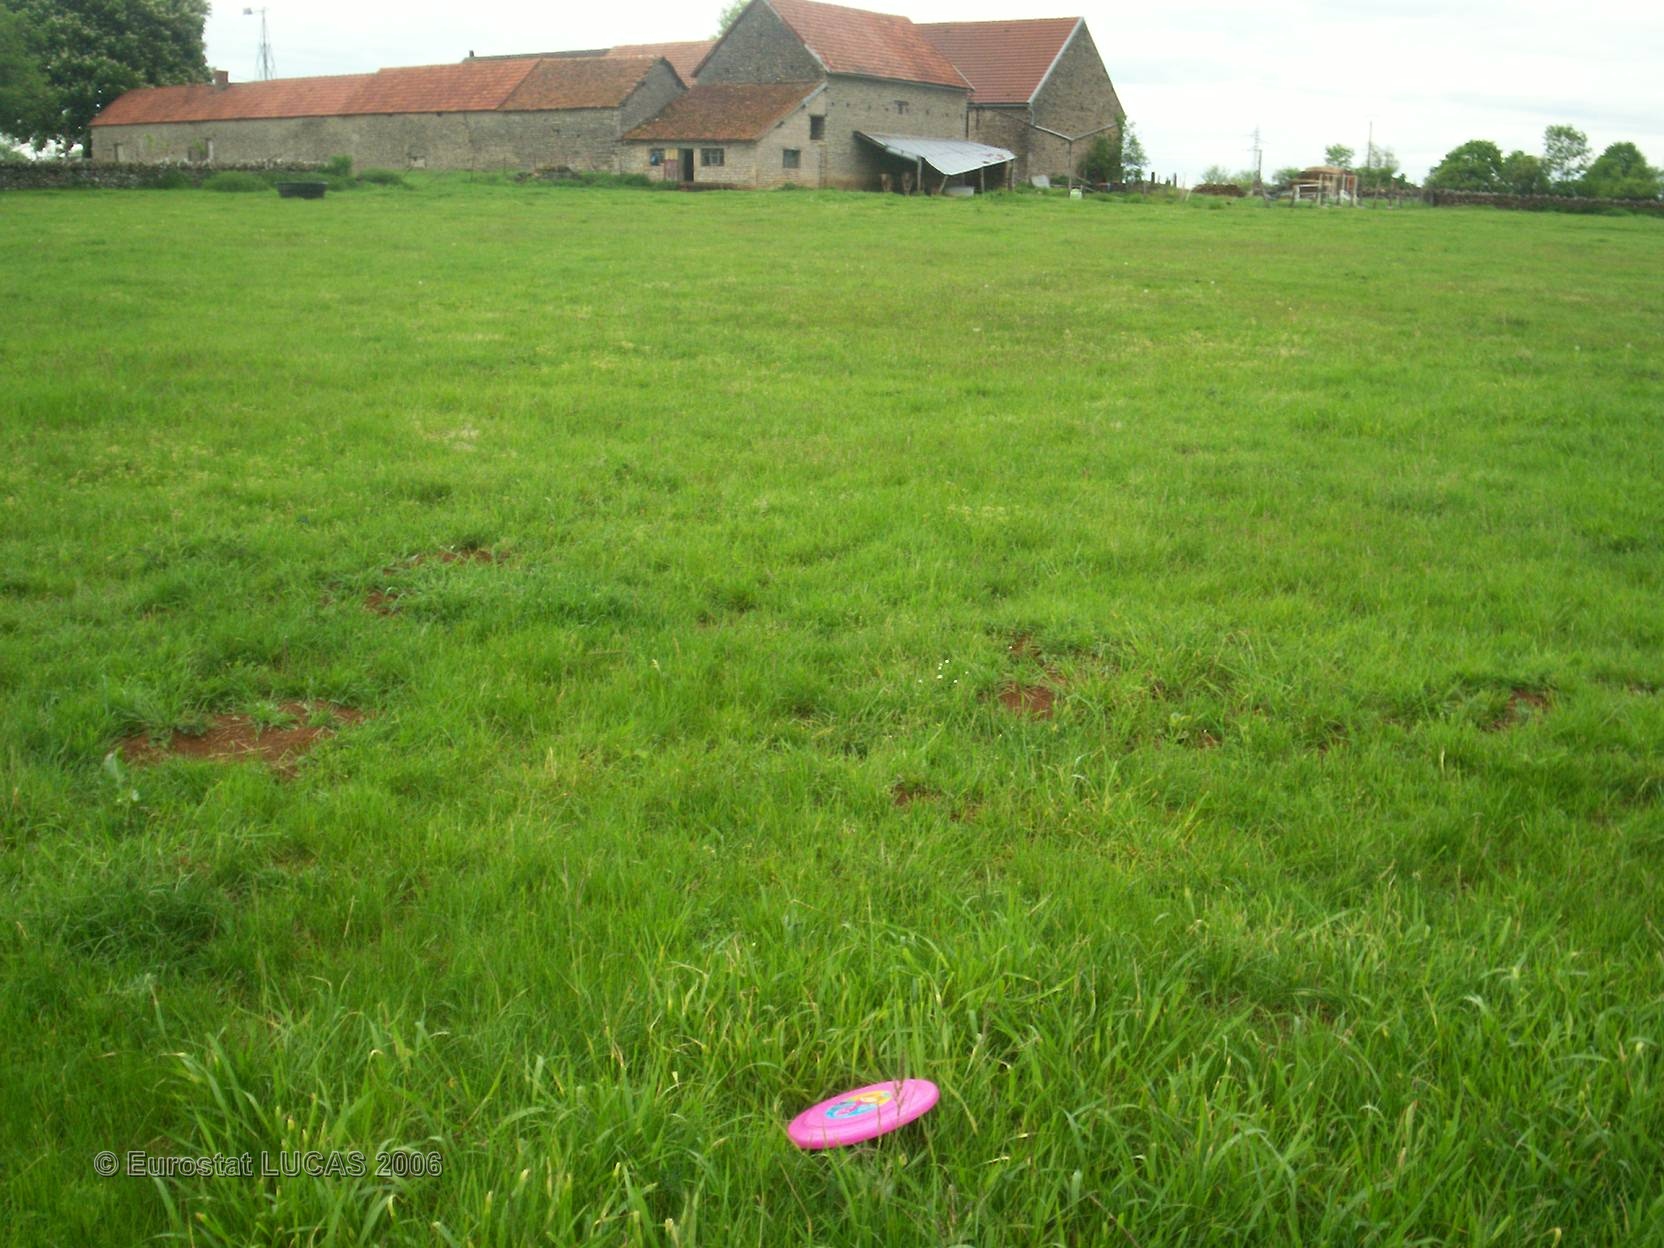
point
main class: Grassland
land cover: Grassland without tree/shrub cover
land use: Agriculture (excluding fallow land and kitchen gardens)
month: May
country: FR
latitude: 47.2805
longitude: 4.6191
